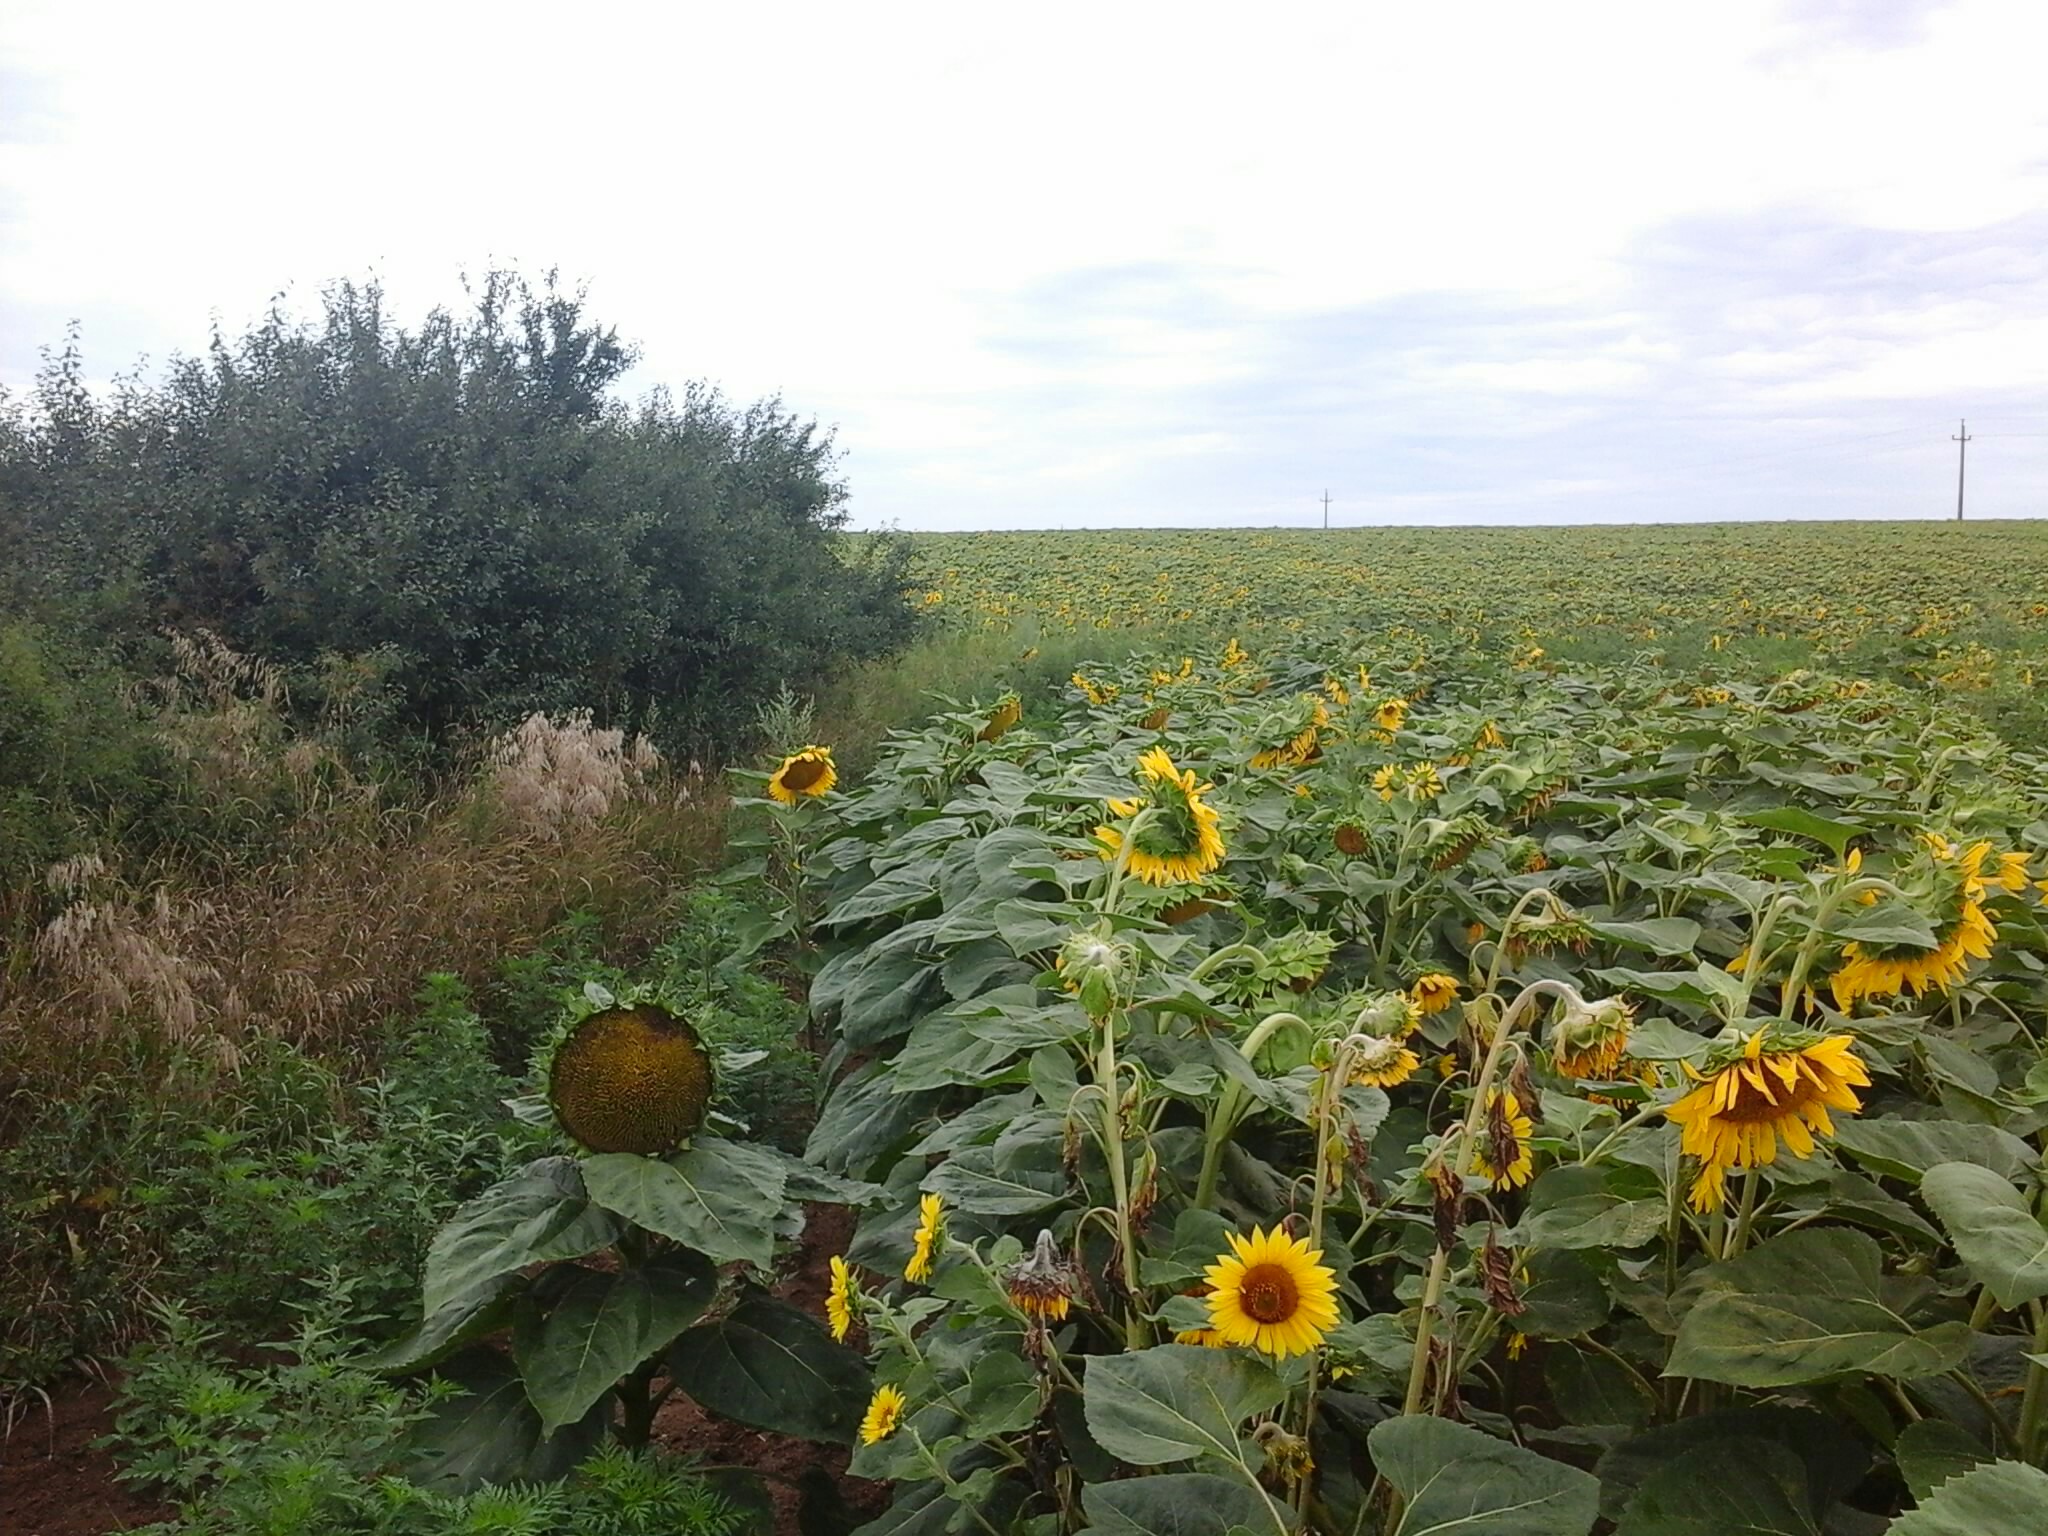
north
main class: Cropland
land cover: Sunflower
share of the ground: > 75 %
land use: Agriculture (excluding fallow land and kitchen gardens)
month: July
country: HU
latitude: 48.4530
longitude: 21.1706
